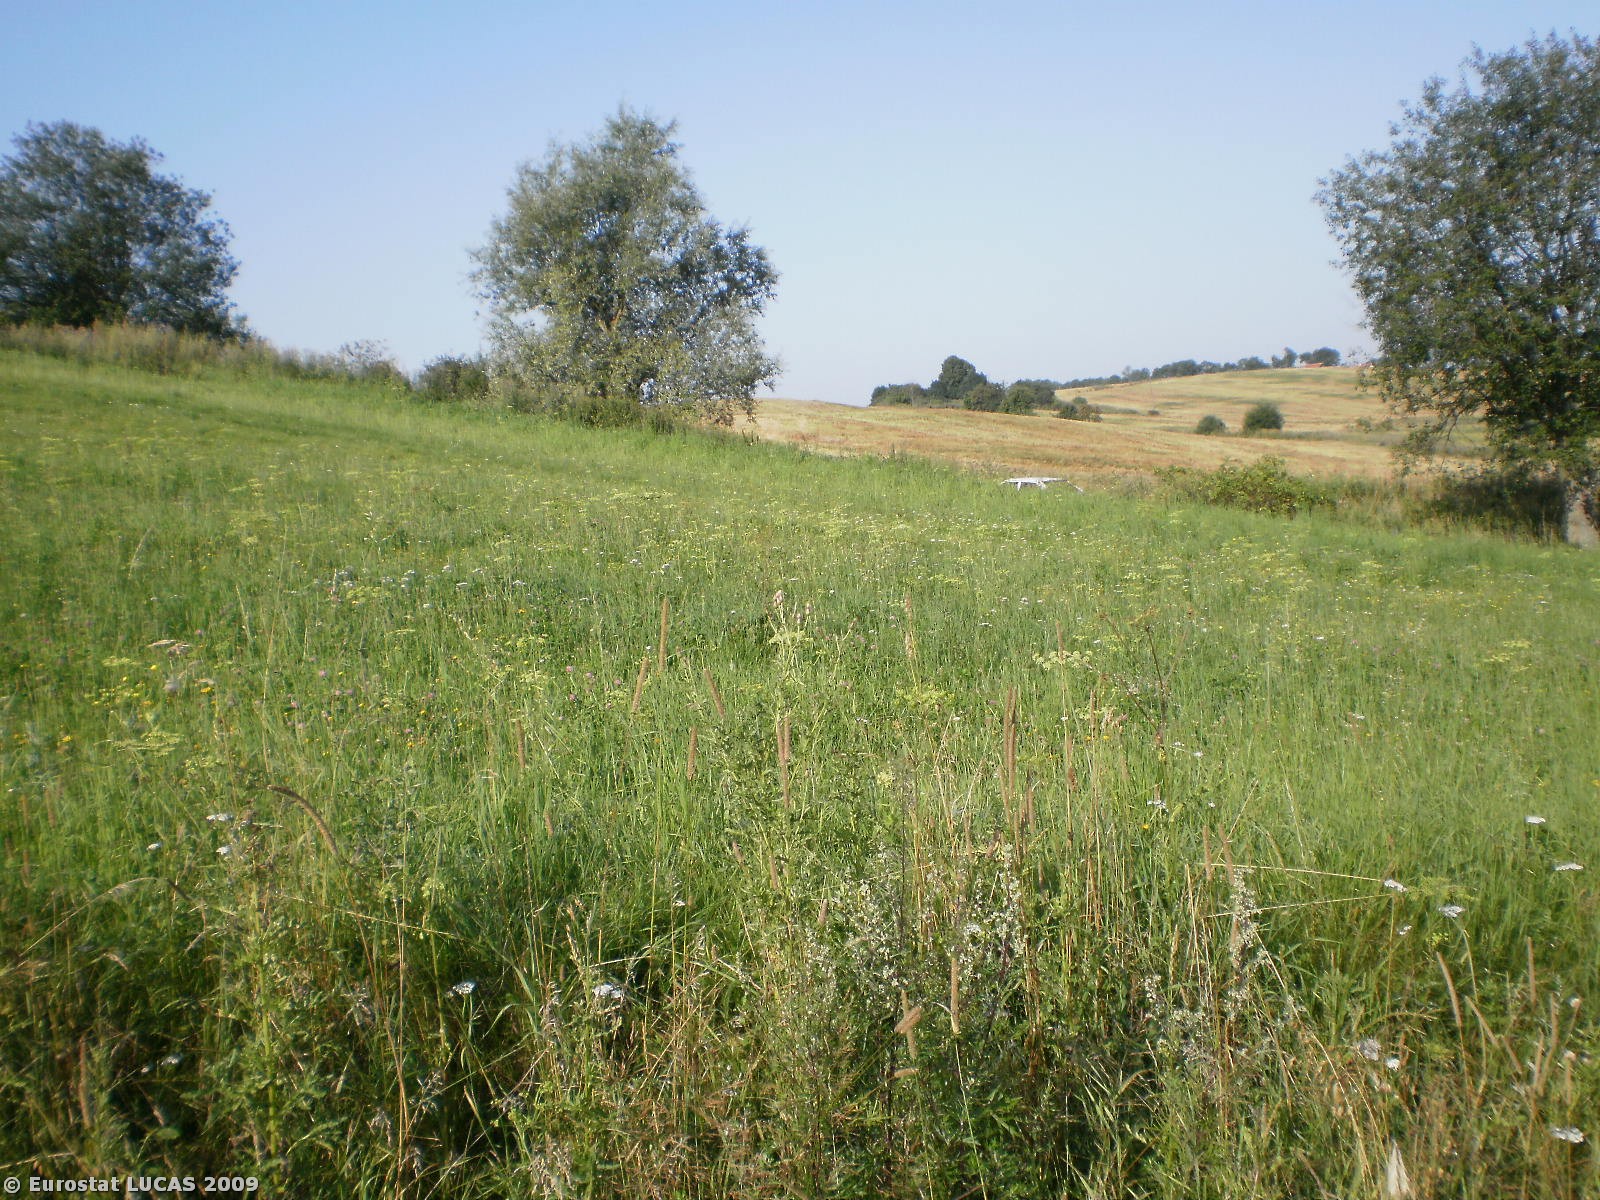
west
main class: Cropland
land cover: Mixed cereals for fodder
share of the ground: > 75 %
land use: Agriculture (excluding fallow land and kitchen gardens)
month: August
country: PL
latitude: 54.0526
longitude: 20.6853
